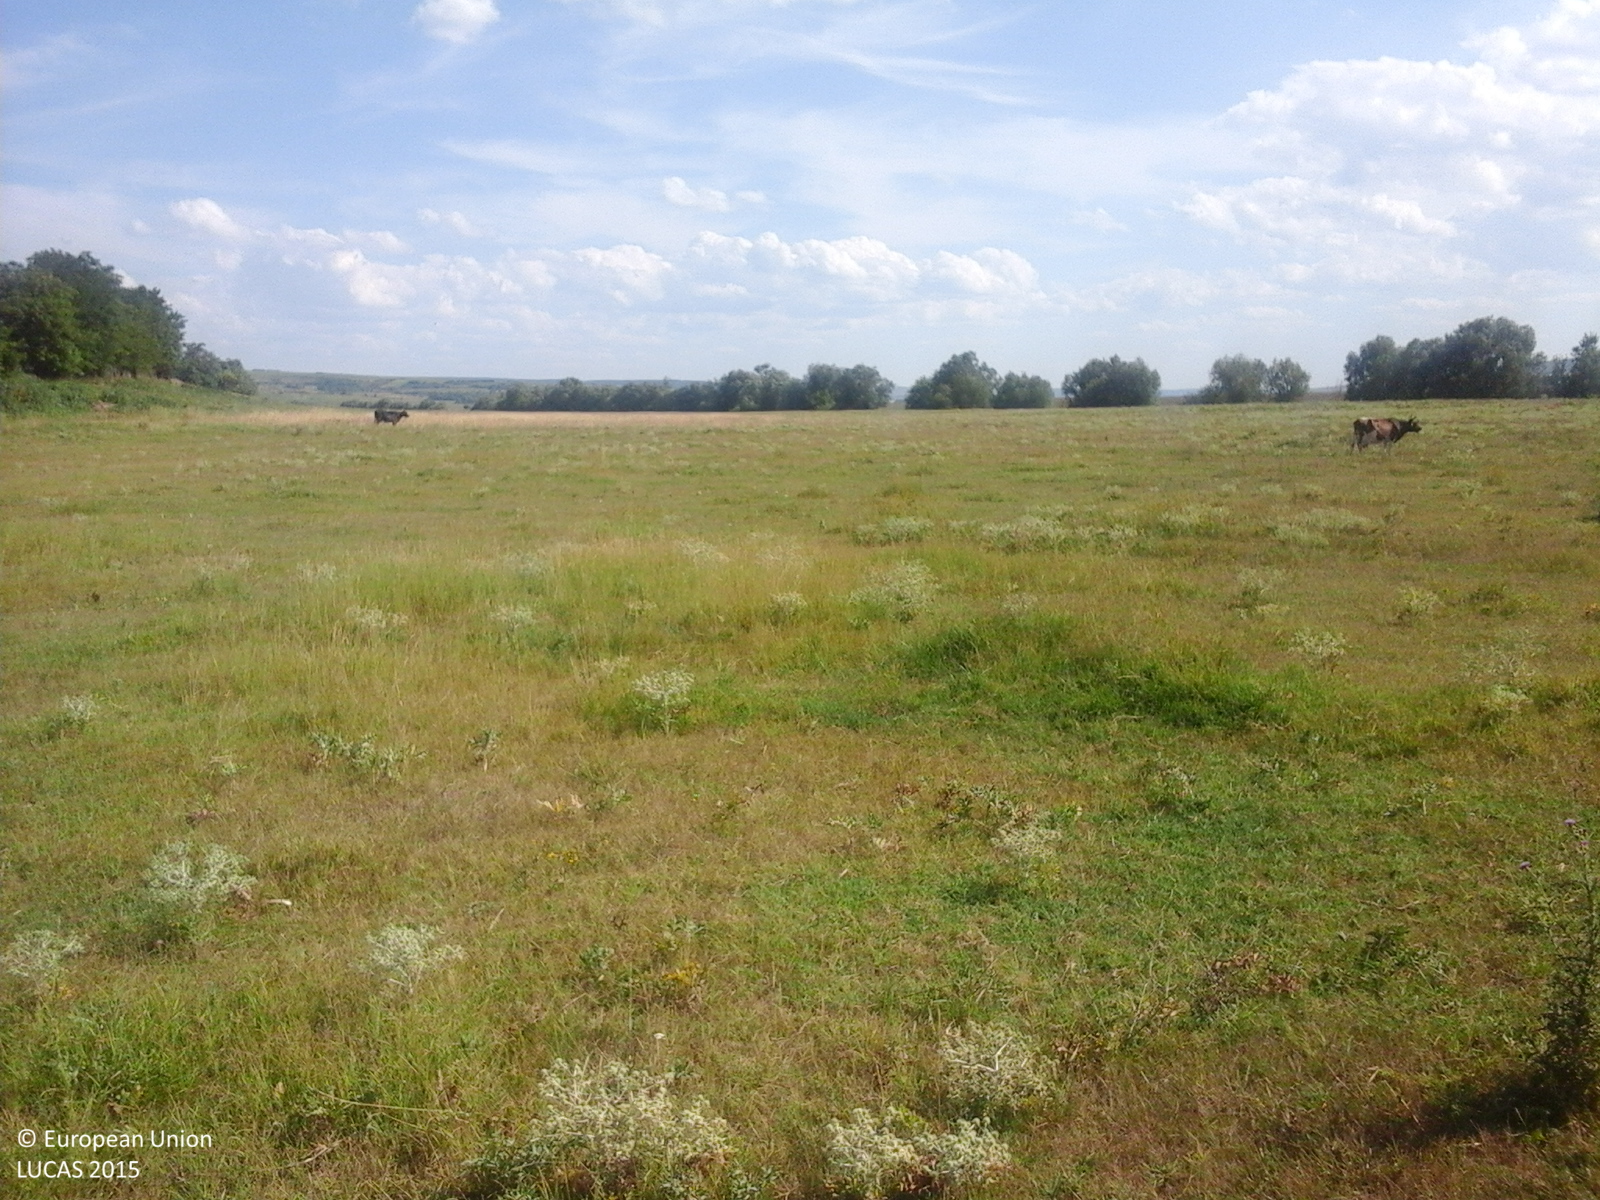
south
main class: Grassland
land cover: Grassland without tree/shrub cover
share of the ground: > 75 %
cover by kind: herbaceous plants 100 %
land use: Agriculture (excluding fallow land and kitchen gardens)
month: July
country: RO
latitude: 46.4963
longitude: 27.8278
